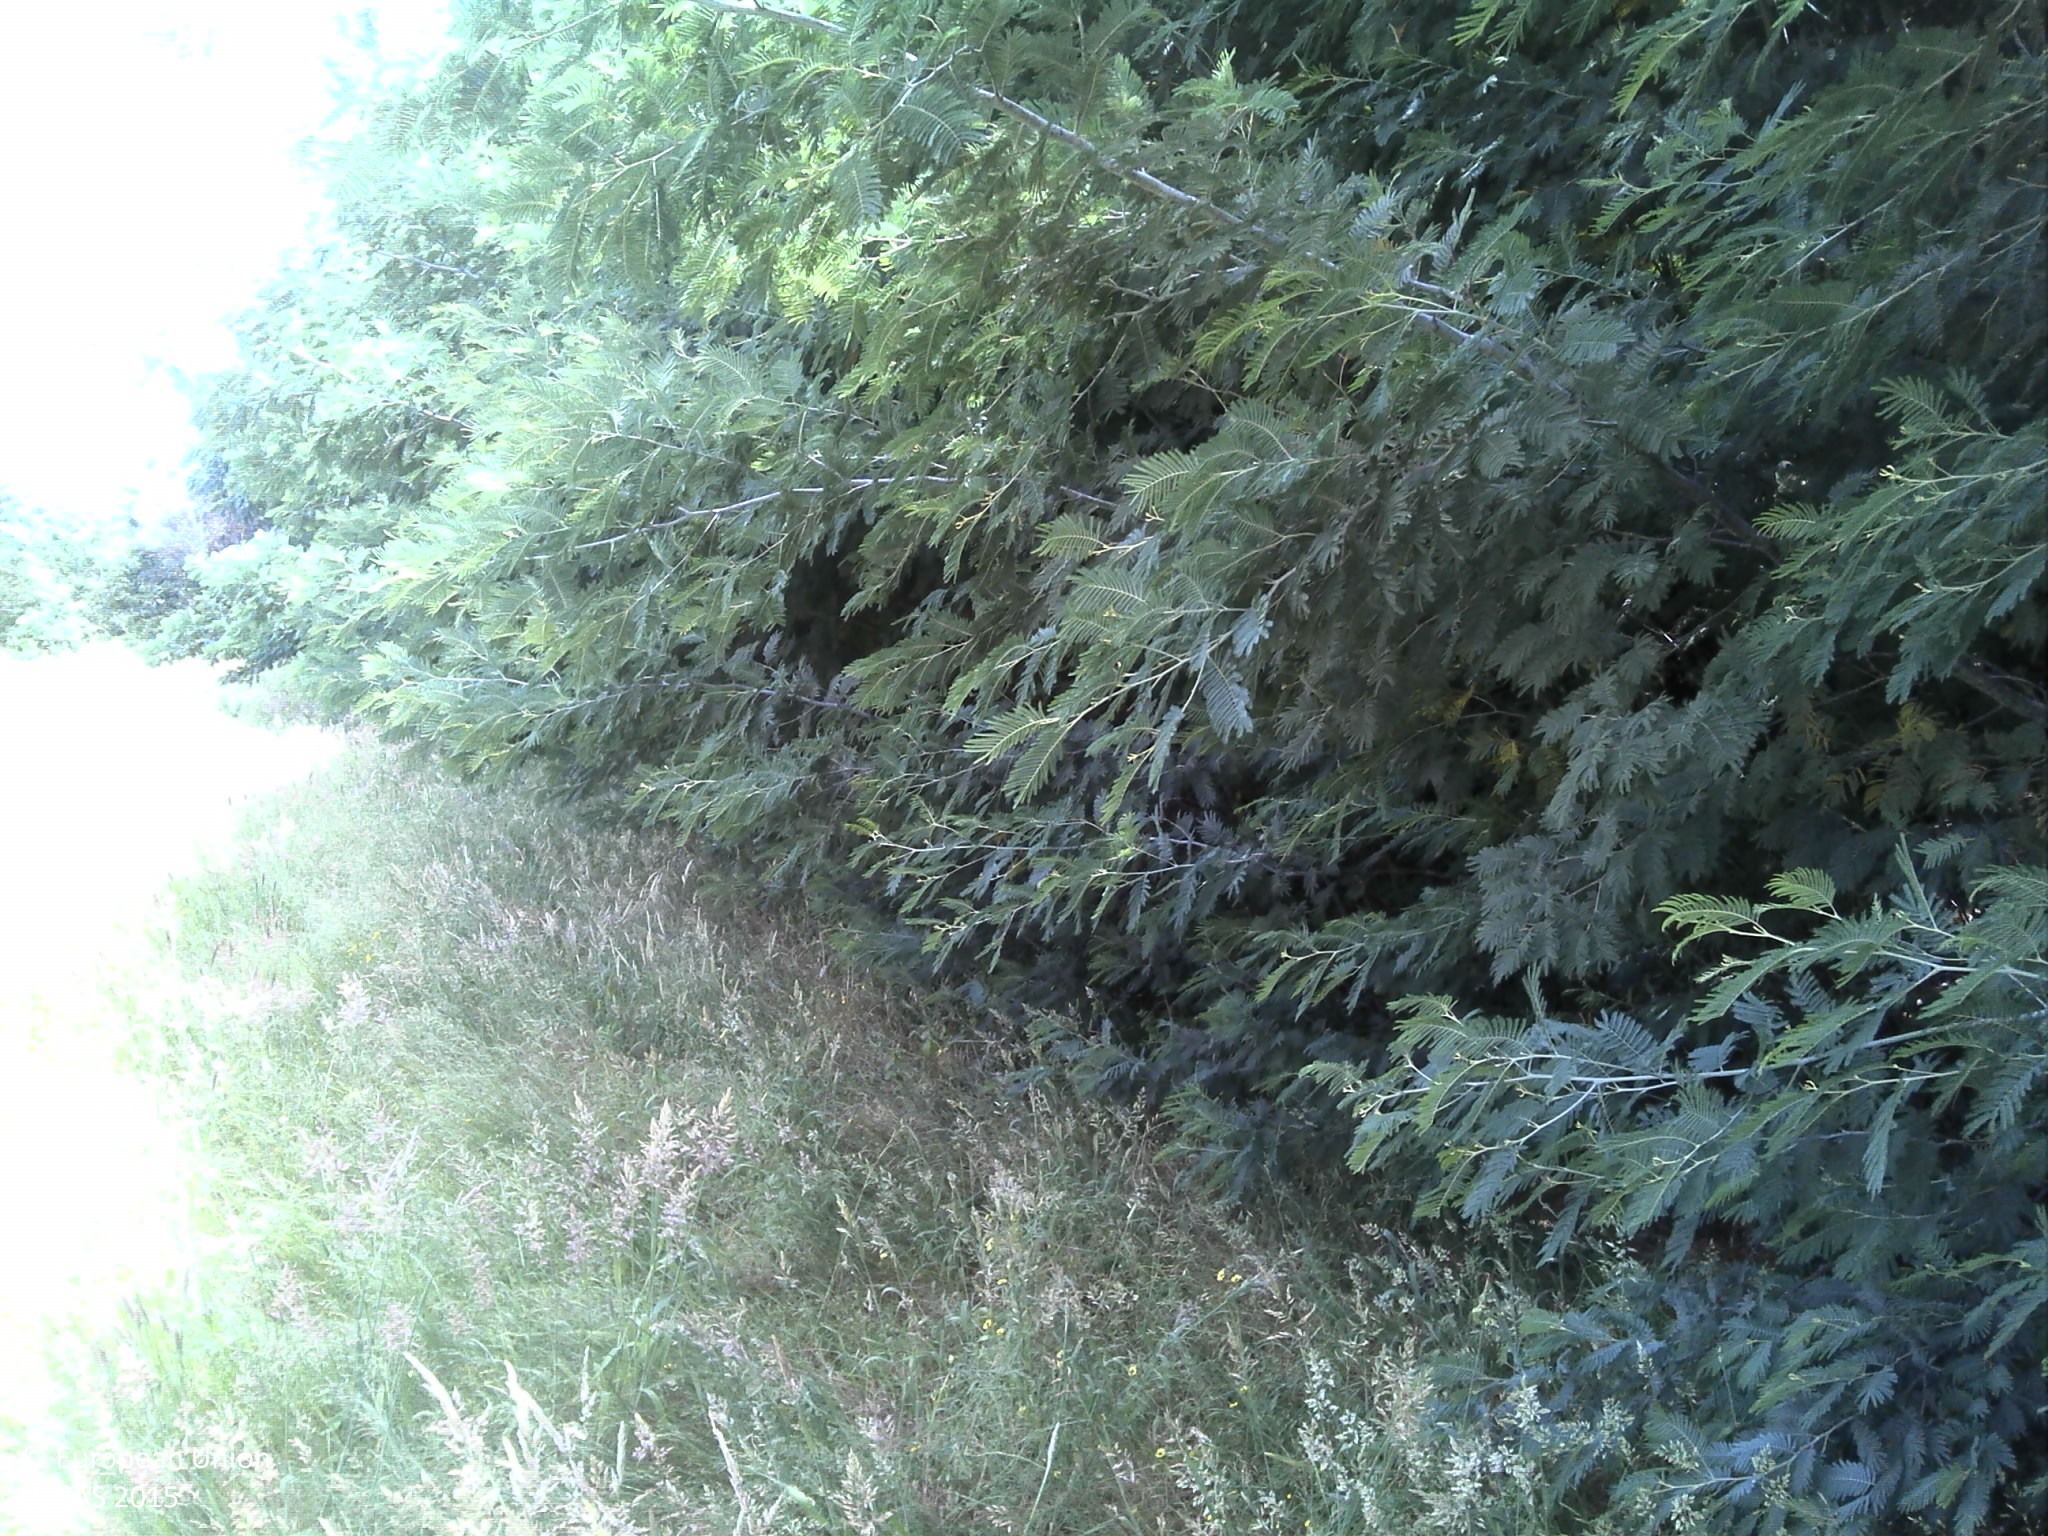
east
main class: Woodland
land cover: Broadleaved woodland
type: exotic forest
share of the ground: > 75 %
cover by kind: broadleaved forest trees 85 %, unconsolidated bare surface 10 %, shrubs 5 %
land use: Forestry
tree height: > 5 m
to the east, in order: Broadleaved woodland; Arable land (only in case pi); Dry stone walls; Arable land (only in case pi); Dry stone walls; Grassland without tree/shrub cover; Single bushes/trees; Arable land (only in case pi)
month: June
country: PT
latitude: 40.1482
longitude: -7.3453
